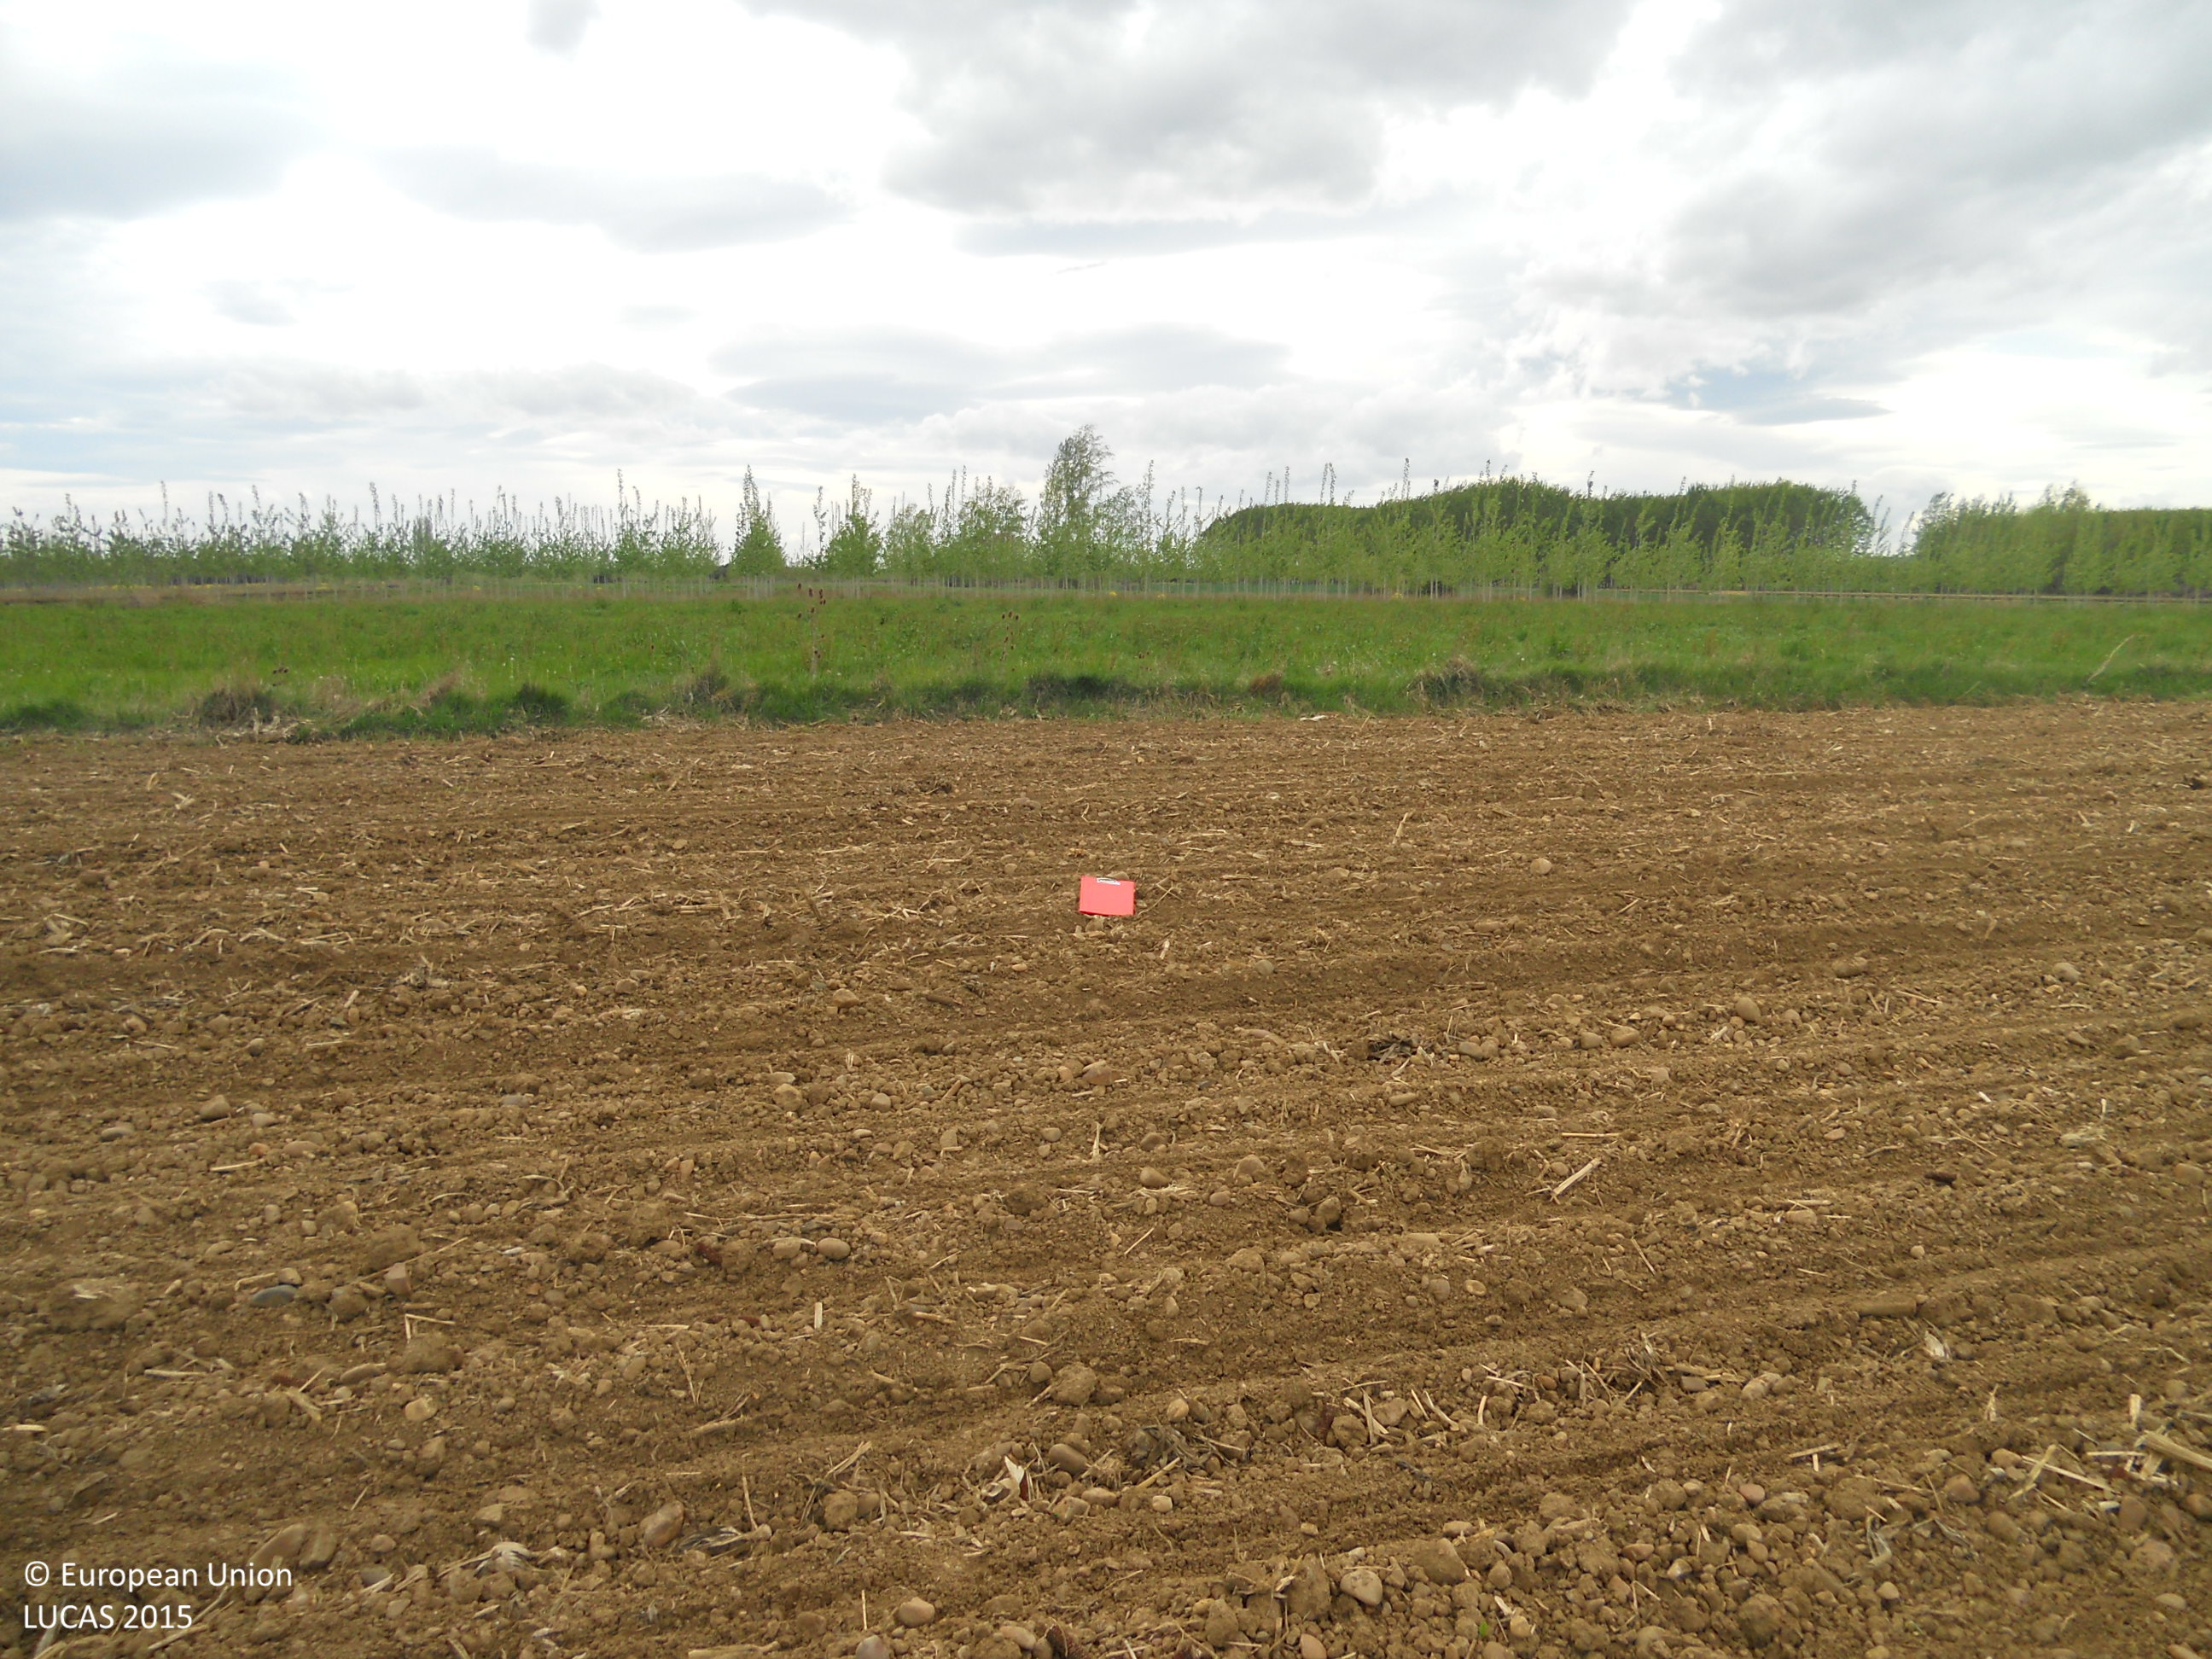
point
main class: Cropland
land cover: Maize
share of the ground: < 10 %
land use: Agriculture (excluding fallow land and kitchen gardens)
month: May
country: ES
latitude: 42.5263
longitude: -5.3203
